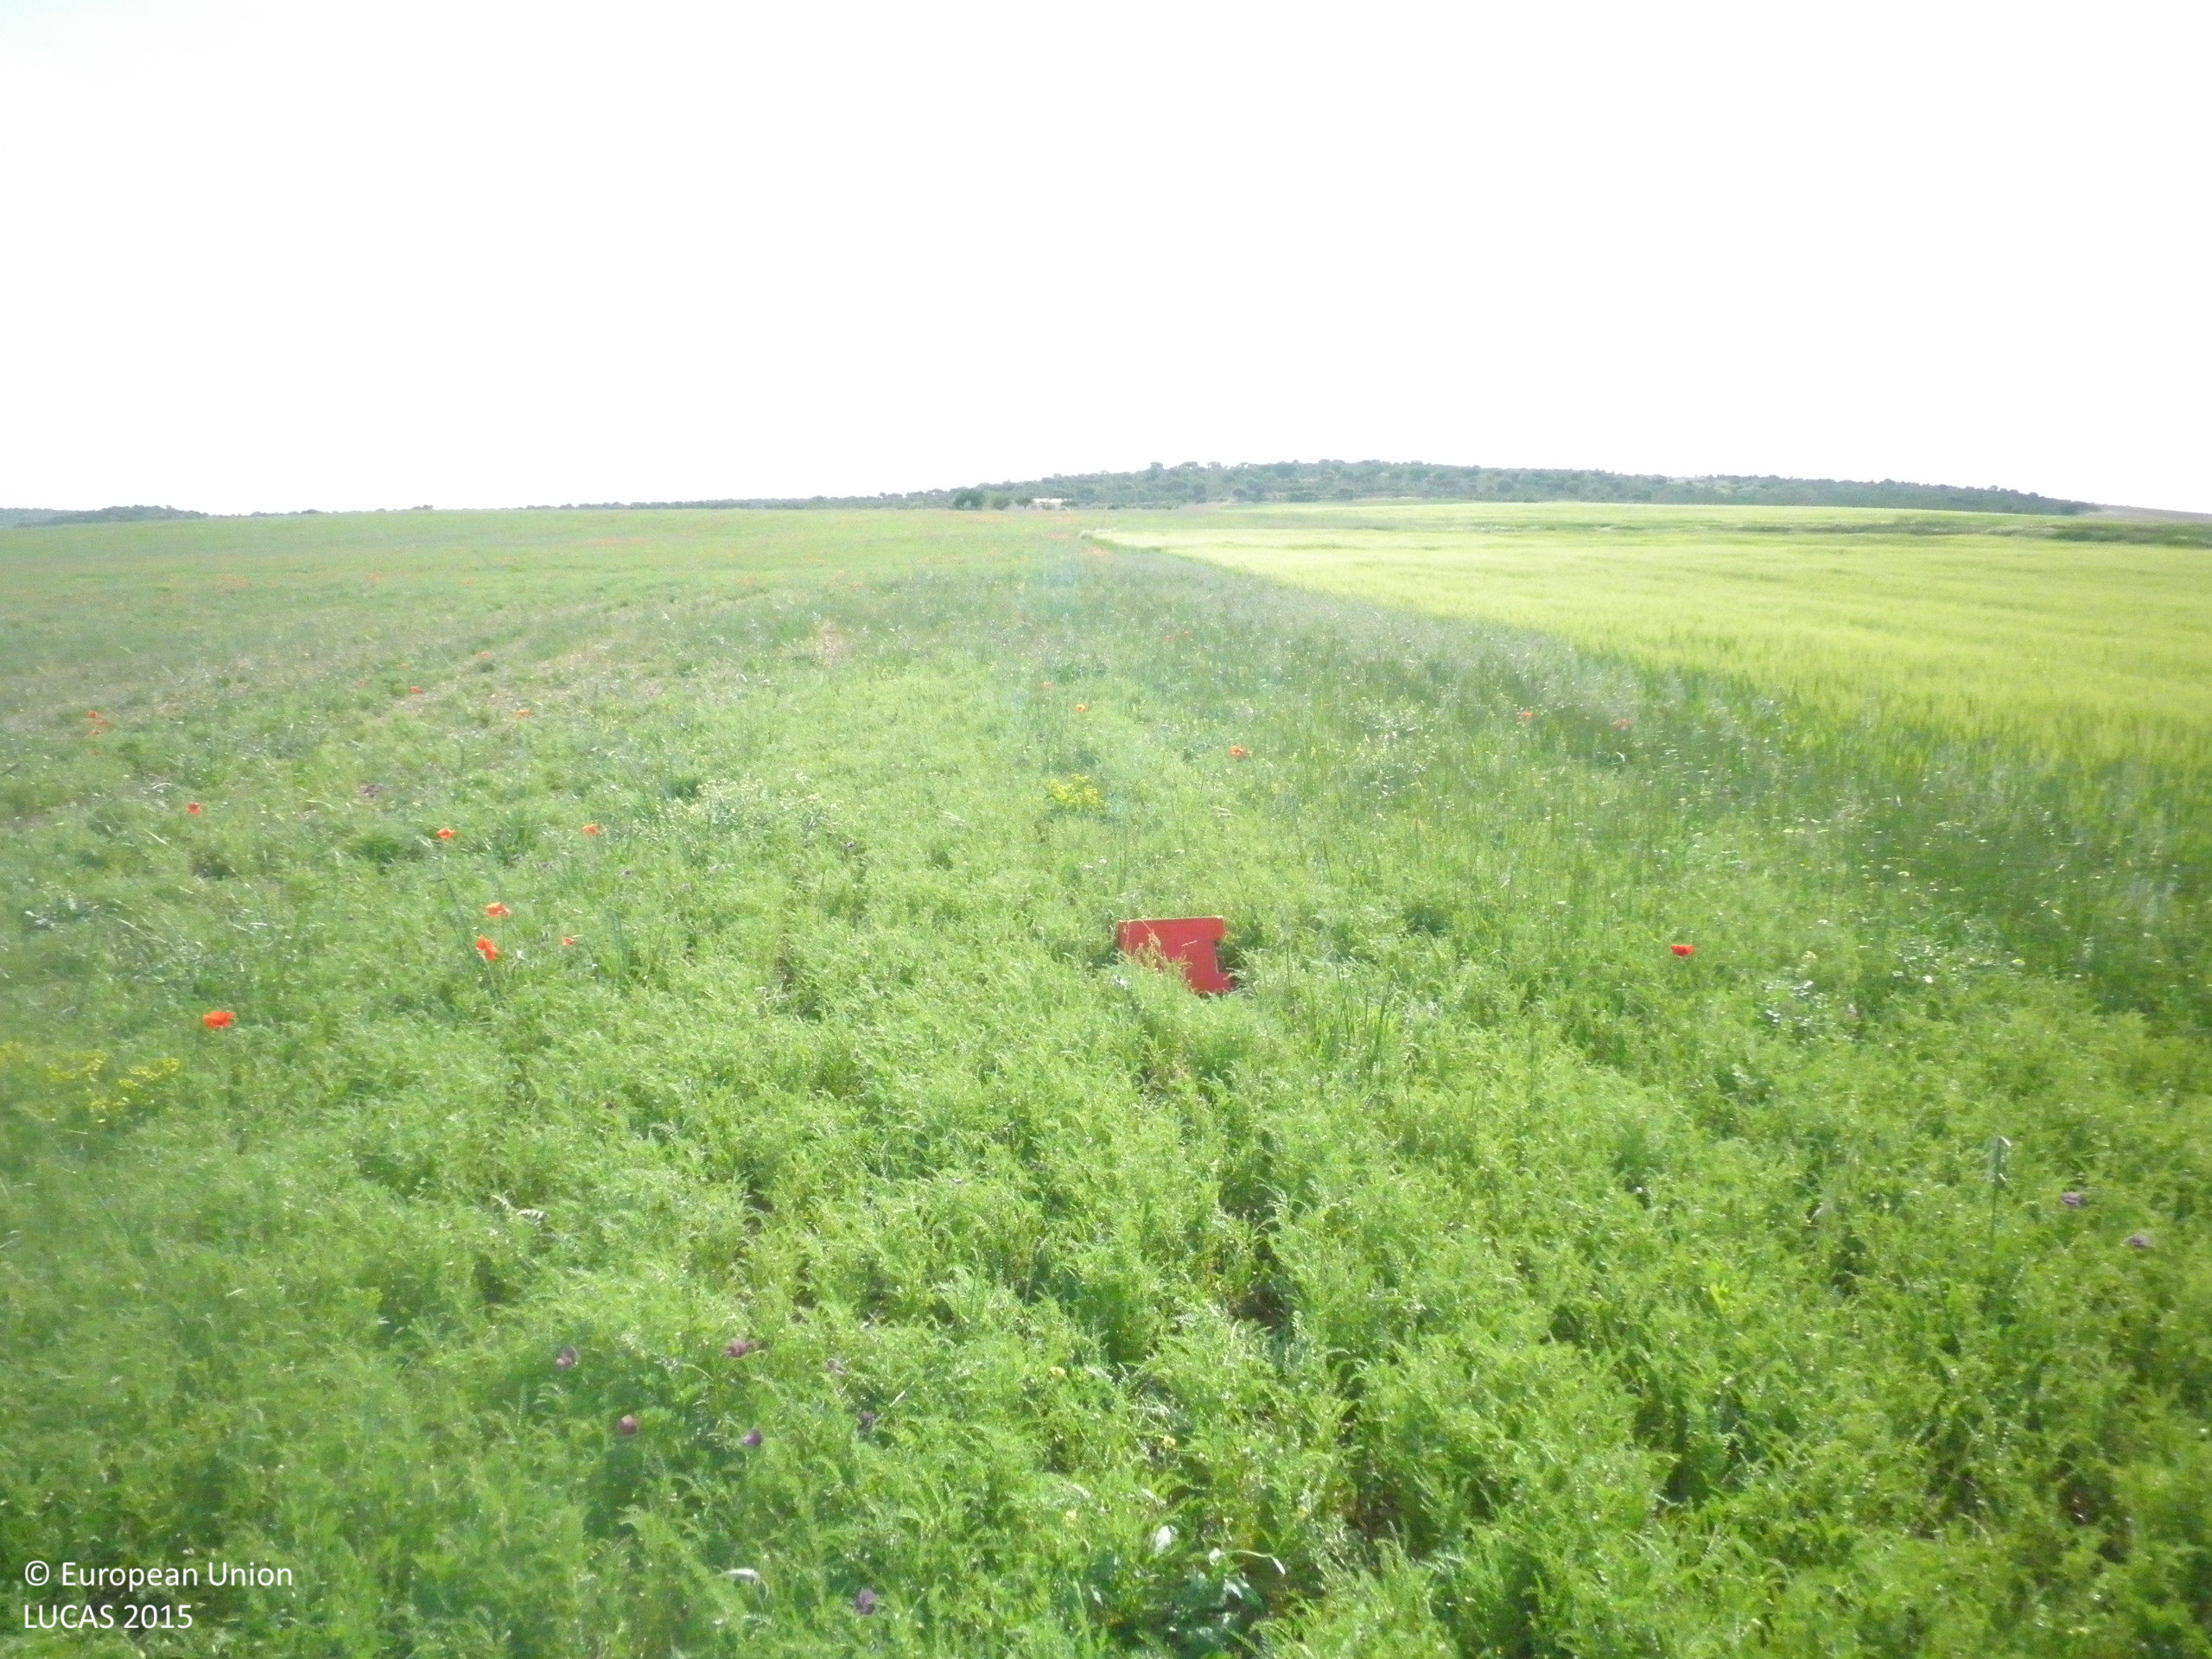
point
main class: Cropland
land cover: Dry pulses
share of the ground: > 75 %
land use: Agriculture (excluding fallow land and kitchen gardens)
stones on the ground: < 10 %
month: May
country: ES
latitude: 39.6241
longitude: -2.6786
